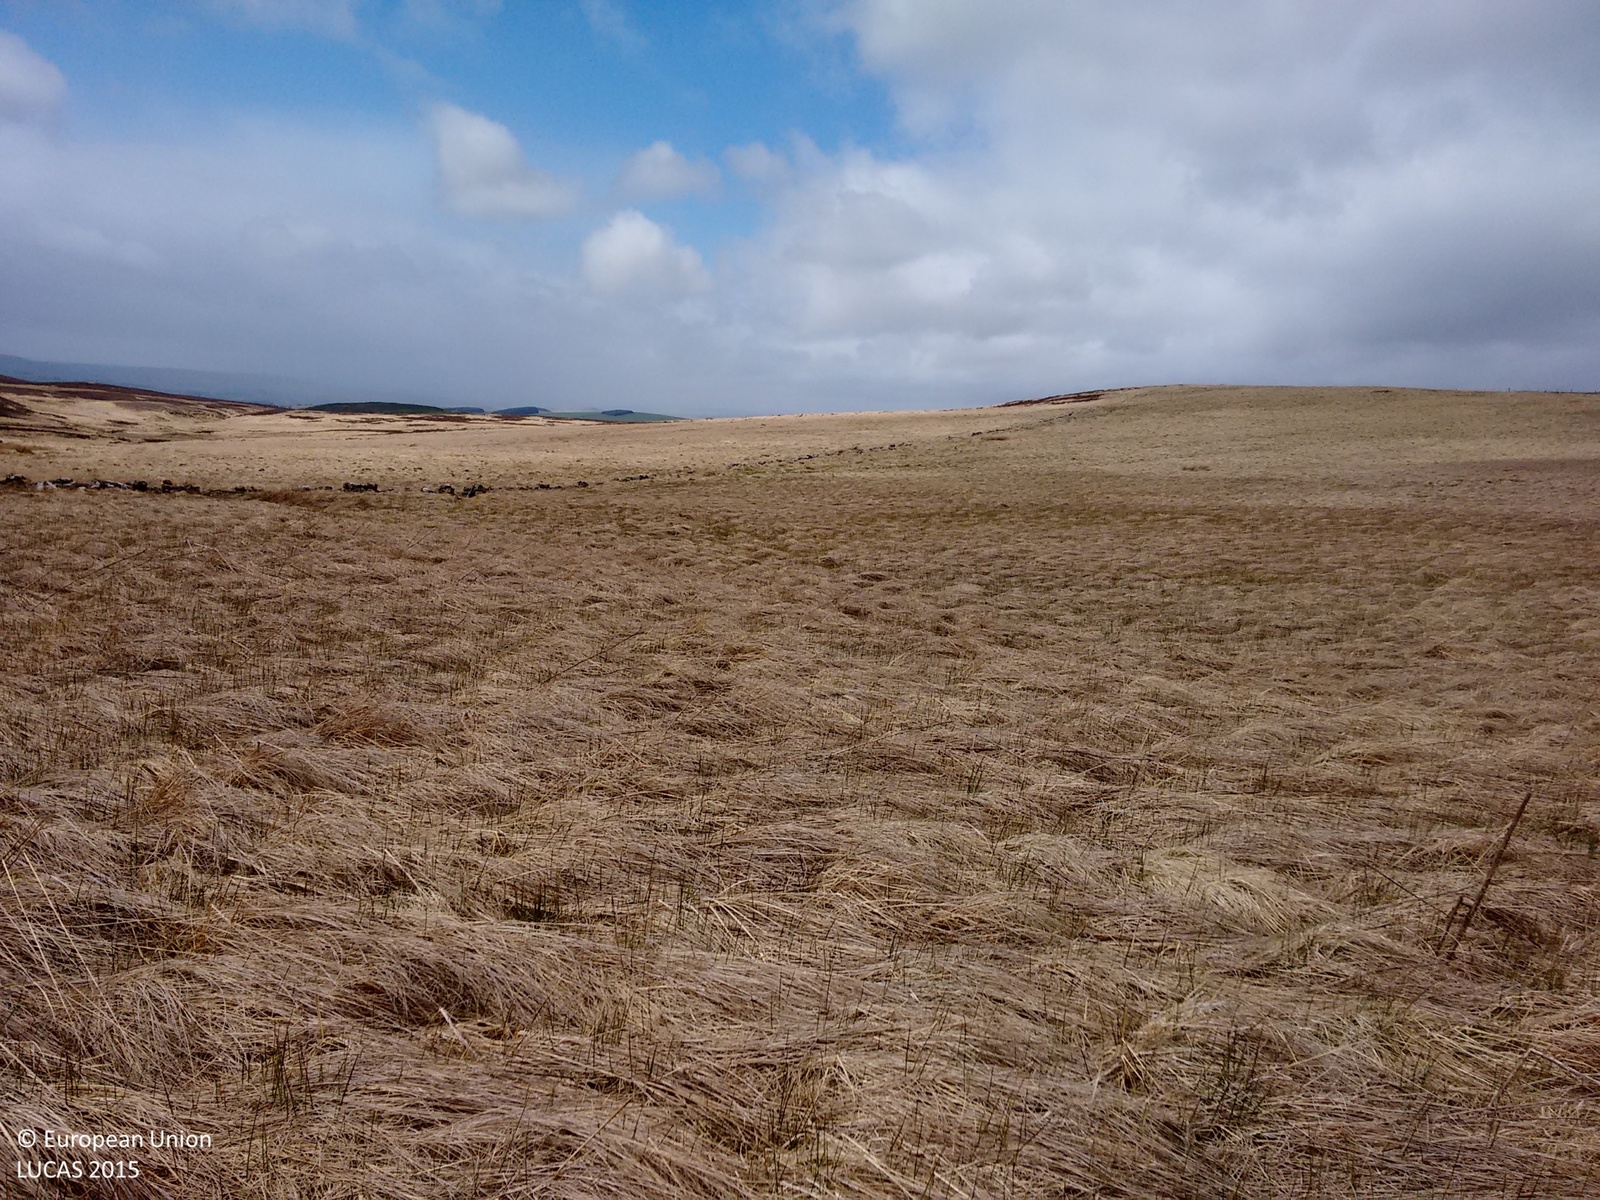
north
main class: Grassland
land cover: Grassland without tree/shrub cover
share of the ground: > 75 %
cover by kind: herbaceous plants 100 %
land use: Agriculture (excluding fallow land and kitchen gardens)
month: May
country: GB
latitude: 55.2143
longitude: -2.0786
